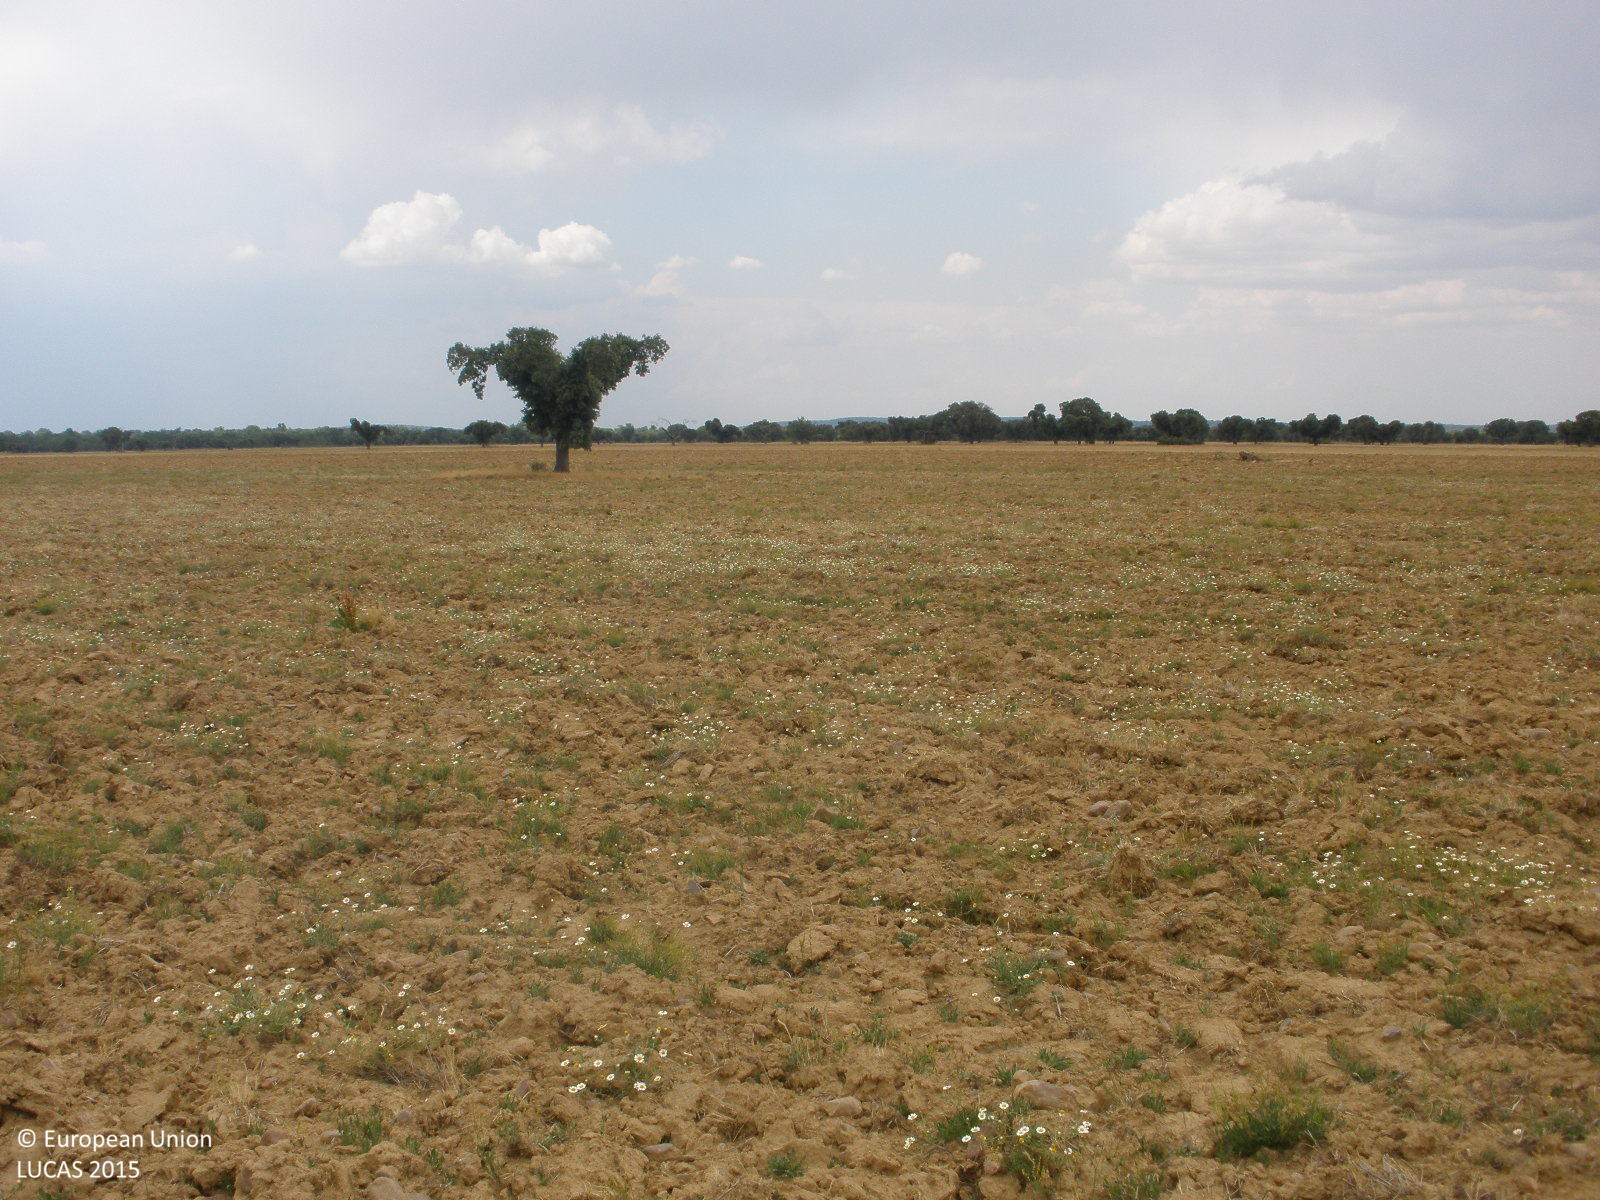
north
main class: Grassland
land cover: Spontaneously vegetated surfaces
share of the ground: 25 - 50 %
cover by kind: unconsolidated bare surface 60 %, herbaceous plants 40 %
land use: Fallow land
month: June
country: ES
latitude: 40.7371
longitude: -6.3948
